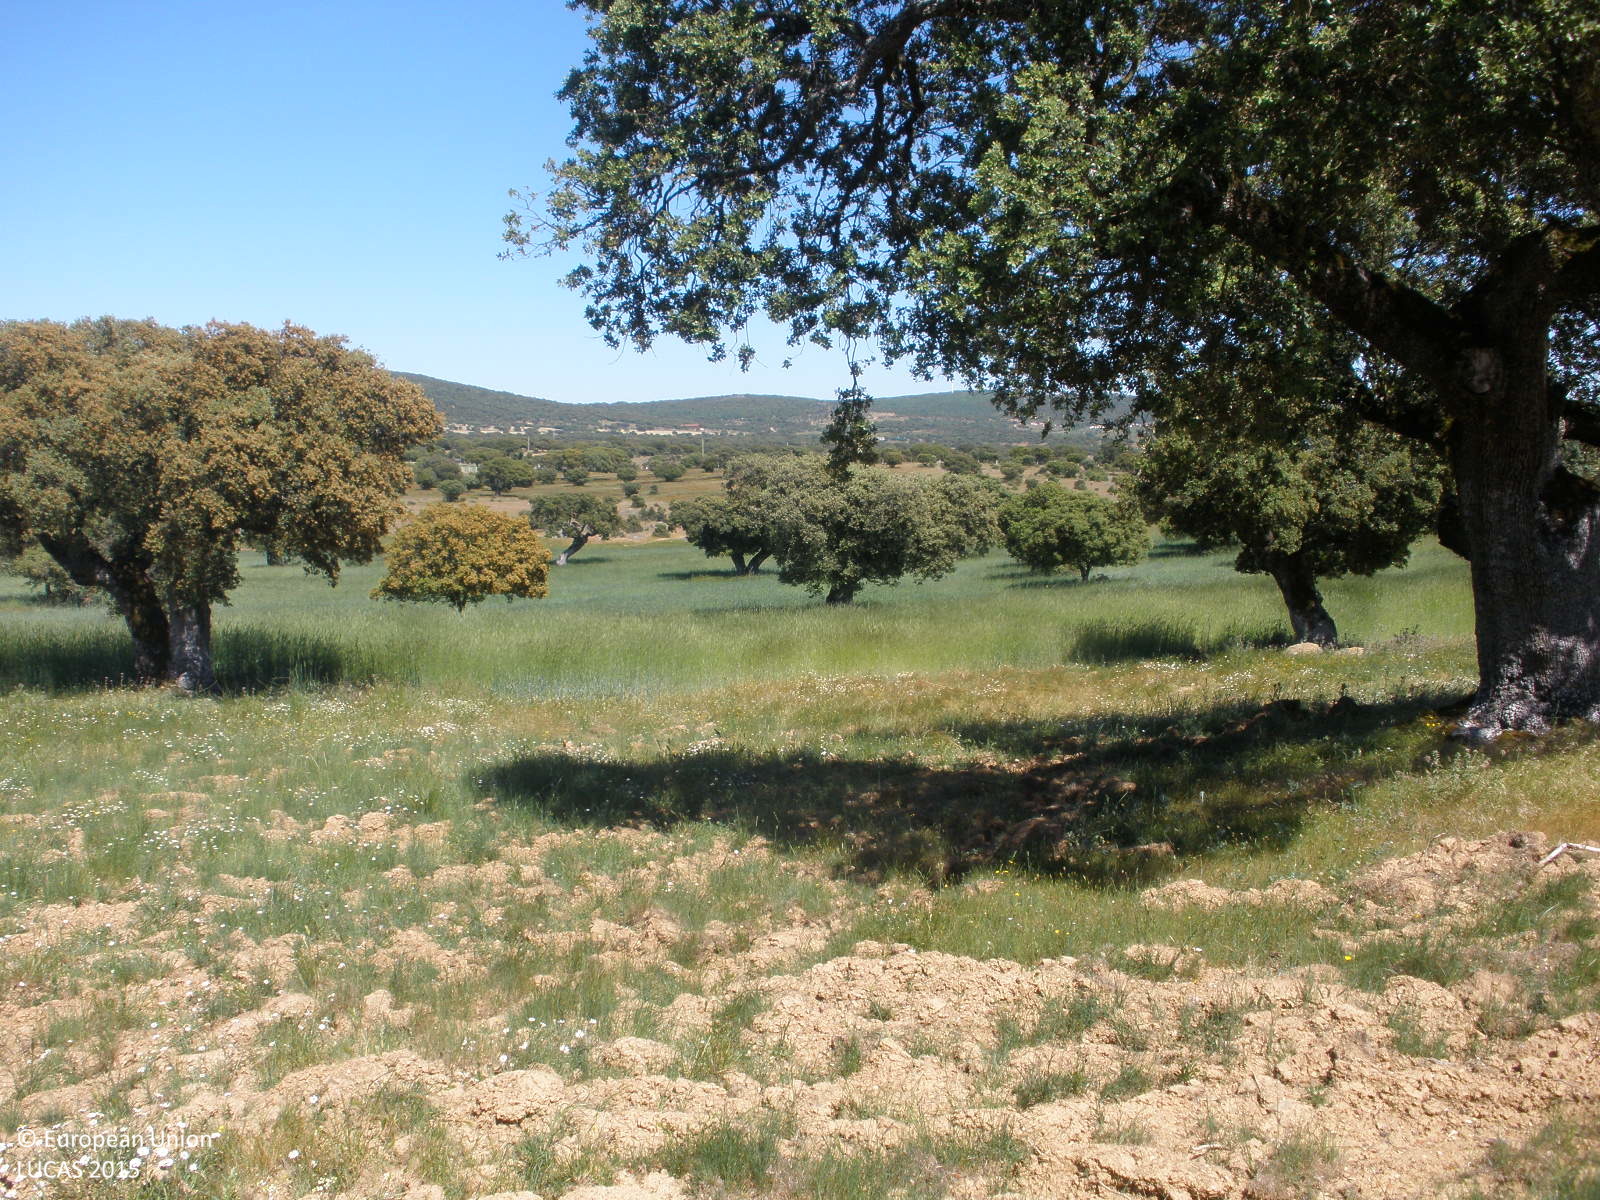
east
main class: Woodland
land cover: Broadleaved woodland
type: broadleaved evergreen forest
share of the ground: 25 - 50 %
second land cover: Grassland without tree/shrub cover
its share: 50 - 75 %
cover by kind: herbaceous plants 50 %, broadleaved forest trees 30 %, unconsolidated bare surface 20 %
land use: Forestry
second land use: Agriculture (excluding fallow land and kitchen gardens)
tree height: < 5 m
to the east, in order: Broadleaved woodland; Grassland without tree/shrub cover; Grassland with sparse tree/shrub cover; Rye; Tracks; Grassland without tree/shrub cover
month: May
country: ES
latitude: 40.6980
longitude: -5.8526
